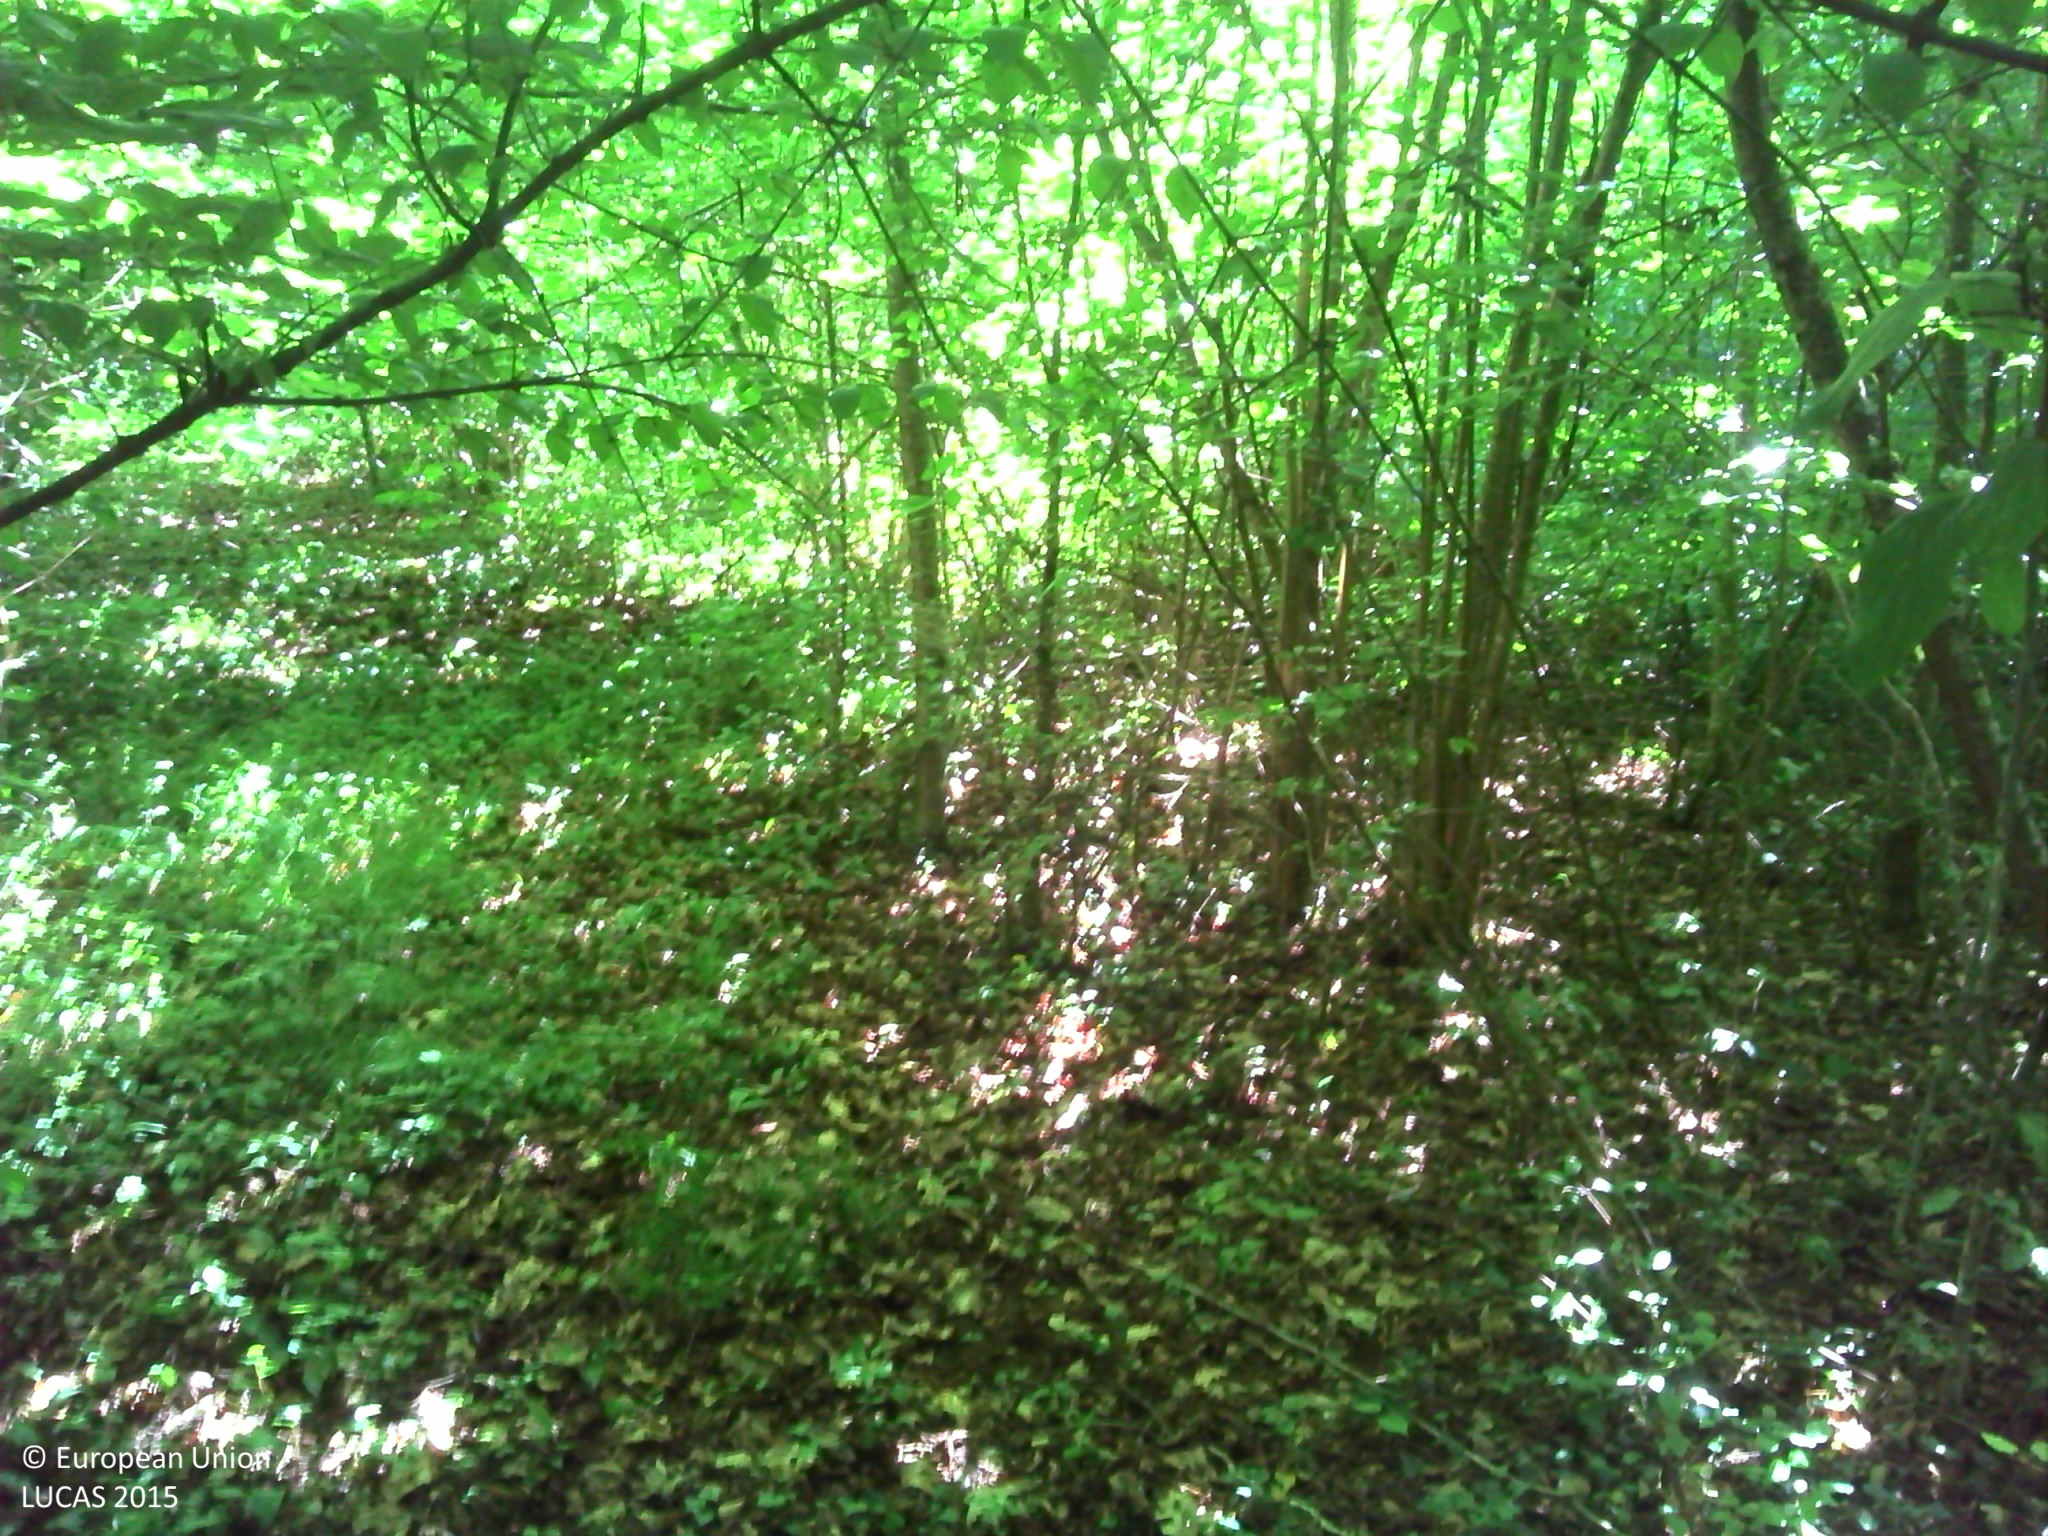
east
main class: Woodland
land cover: Broadleaved woodland
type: mesophytic deciduous forest
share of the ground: > 75 %
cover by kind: broadleaved forest trees 95 %, lichens and mosses 5 %
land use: Forestry
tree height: > 5 m
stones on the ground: < 10 %
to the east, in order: Broadleaved woodland; Tracks; Broadleaved woodland
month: June
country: FR
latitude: 48.9965
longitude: 5.9675
